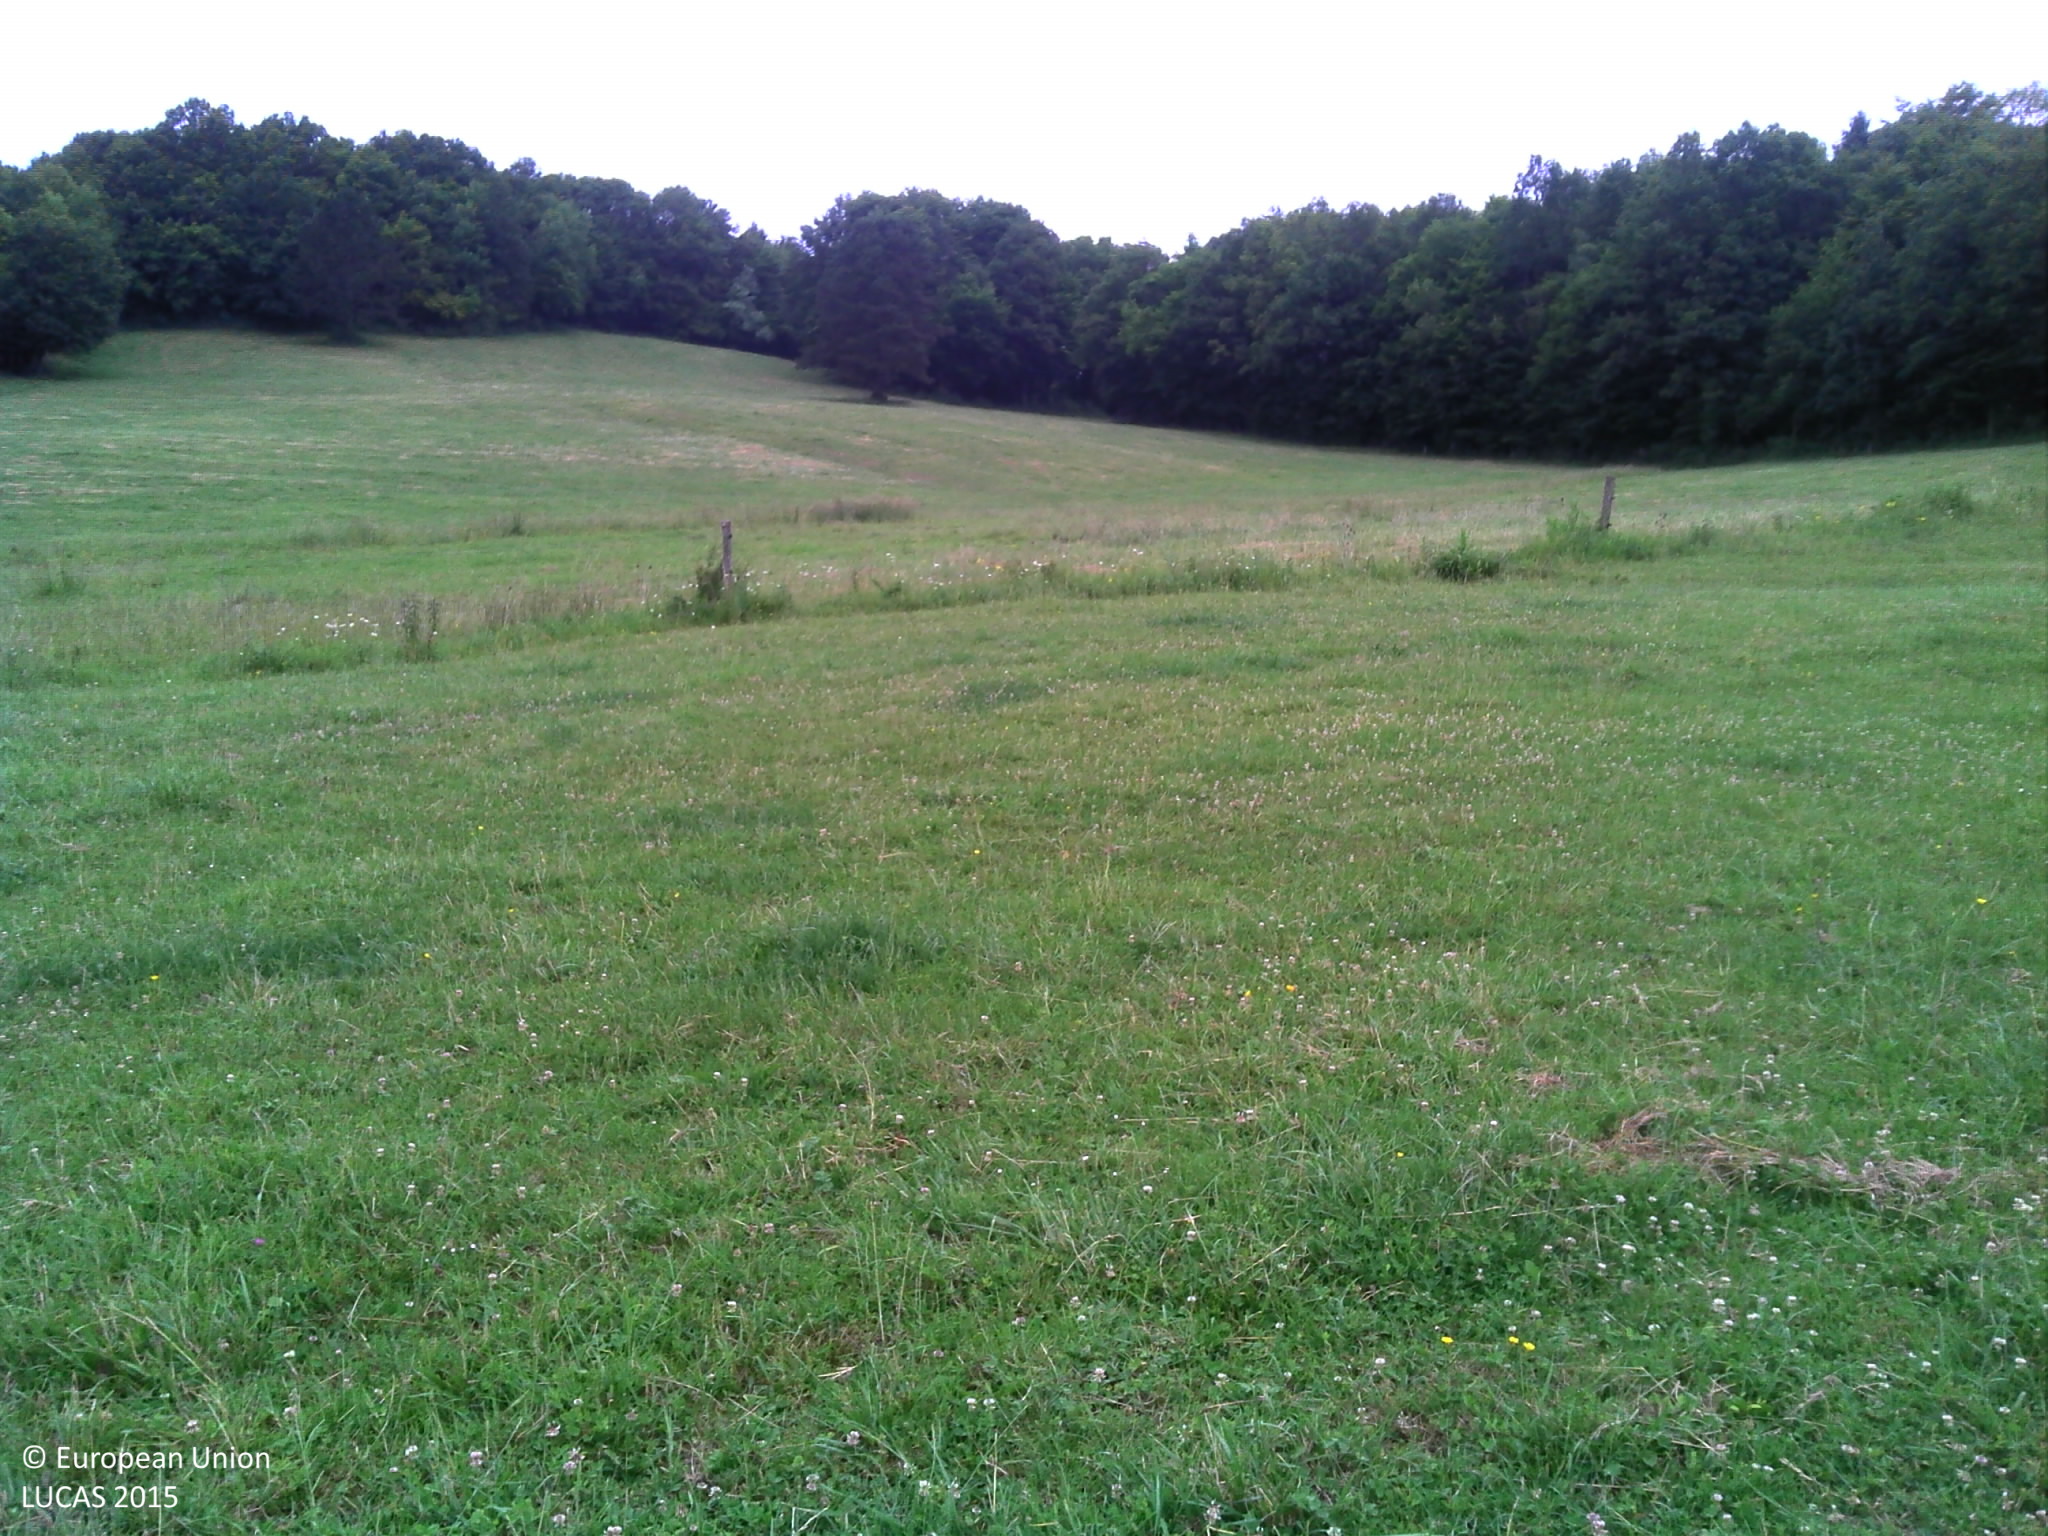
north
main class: Grassland
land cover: Grassland without tree/shrub cover
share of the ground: > 75 %
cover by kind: herbaceous plants 100 %
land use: Agriculture (excluding fallow land and kitchen gardens)
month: June
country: FR
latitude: 47.7303
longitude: 6.3345
